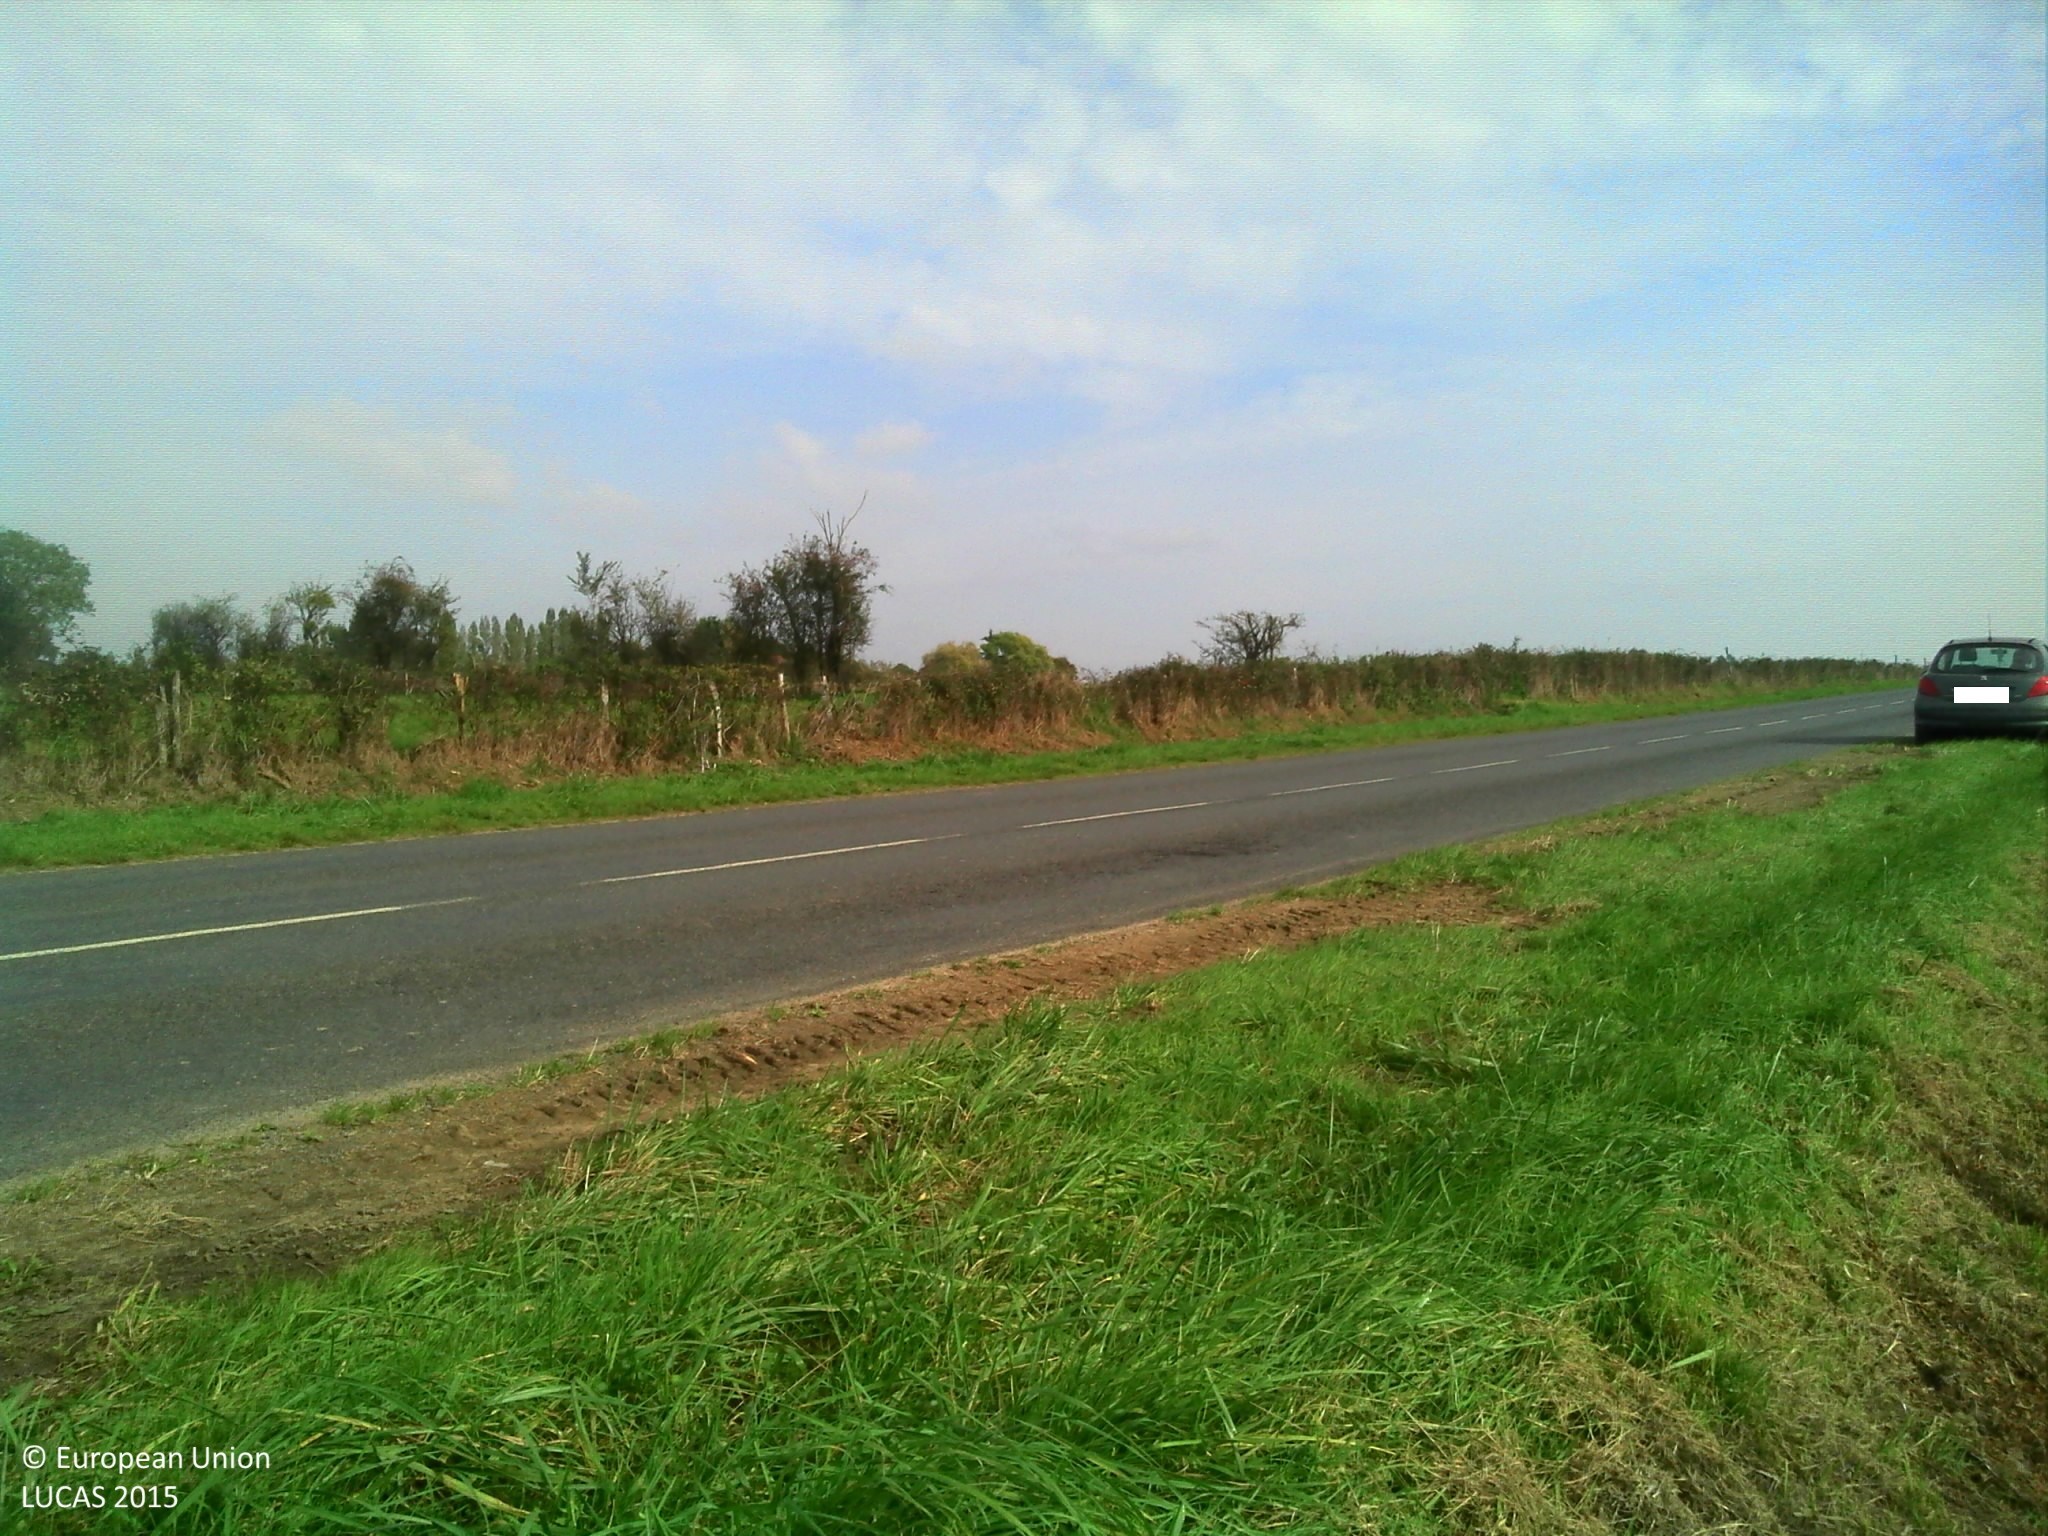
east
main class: Grassland
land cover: Grassland without tree/shrub cover
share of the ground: > 75 %
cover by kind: herbaceous plants 100 %
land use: Agriculture (excluding fallow land and kitchen gardens)
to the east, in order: Grassland without tree/shrub cover; Fences; Electric lines; Ditches and canals; Grass margins; Paved roads, cycling and walking lanes; Grass margins; Ditches and canals; Managed hedges; Fences; Grass margins; Other bare soil
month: October
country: FR
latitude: 47.0920
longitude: -0.9819
